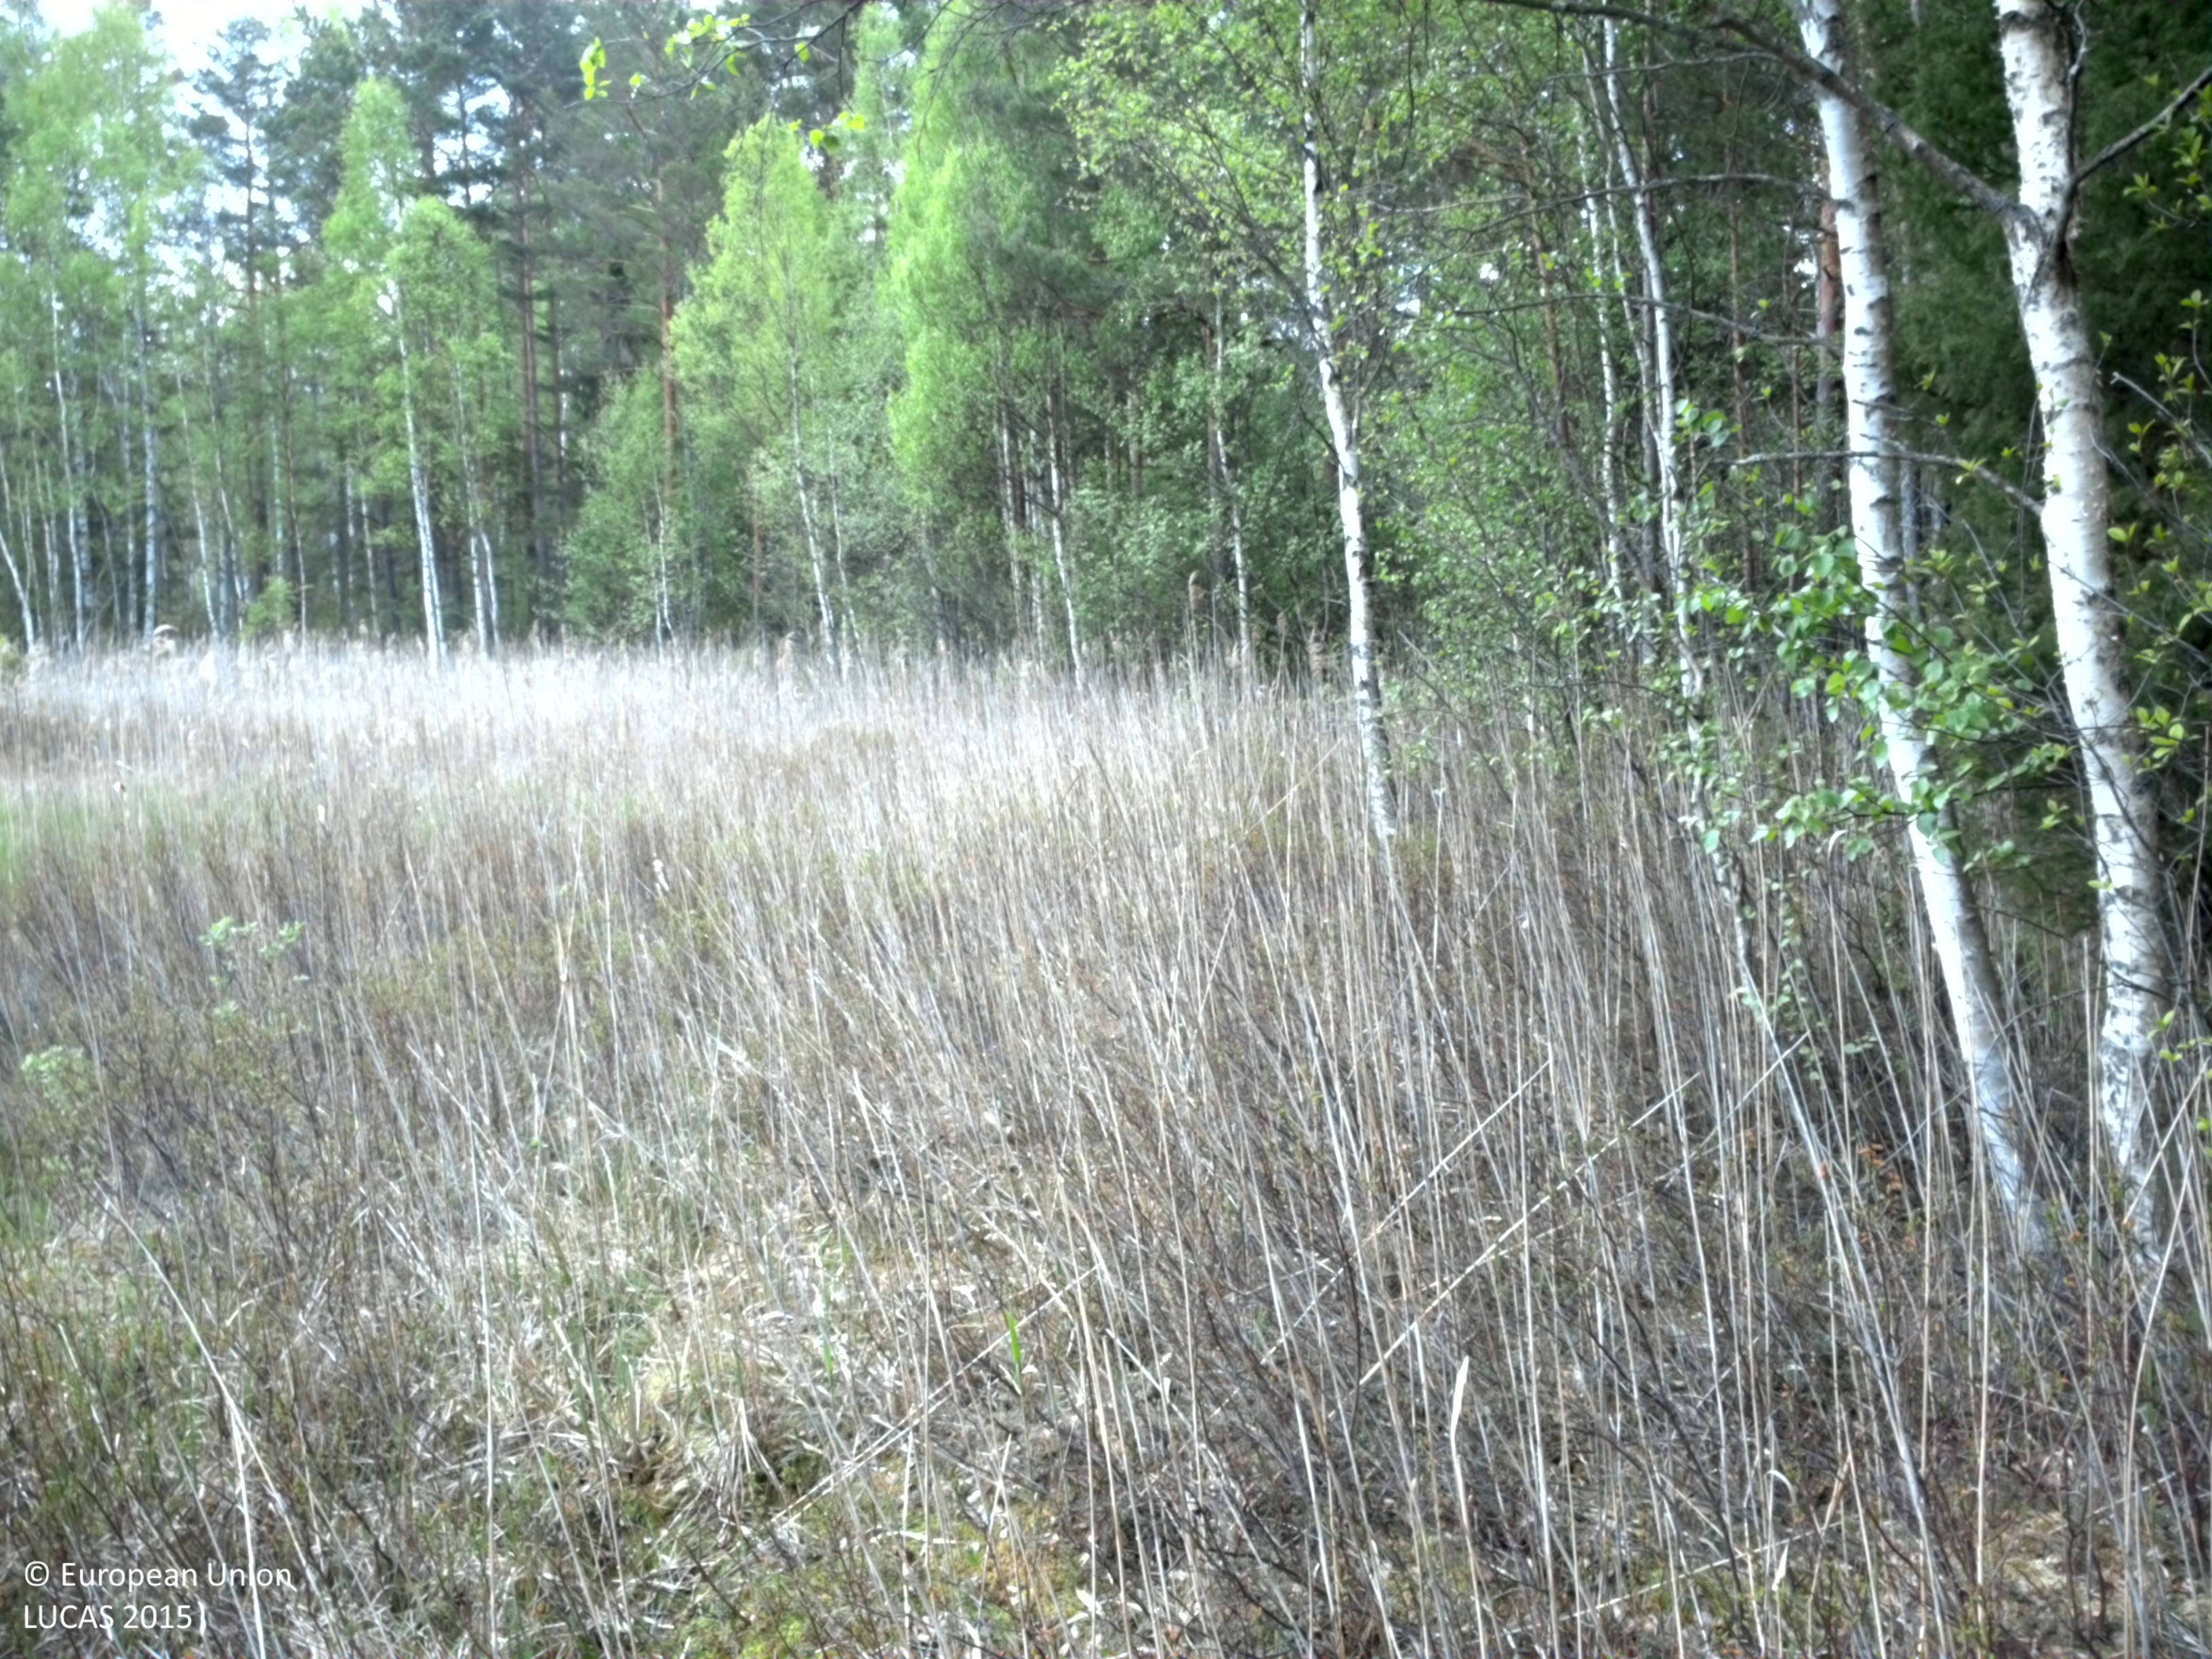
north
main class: Shrubland
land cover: Shrubland with sparse tree cover
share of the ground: 25 - 50 %
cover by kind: lichens and mosses 60 %, shrubs 25 %, herbaceous plants 10 %, broadleaved forest trees 5 %
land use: Semi-natural and natural areas not in use
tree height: < 5 m
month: May
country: SE
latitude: 57.4215
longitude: 15.5086
